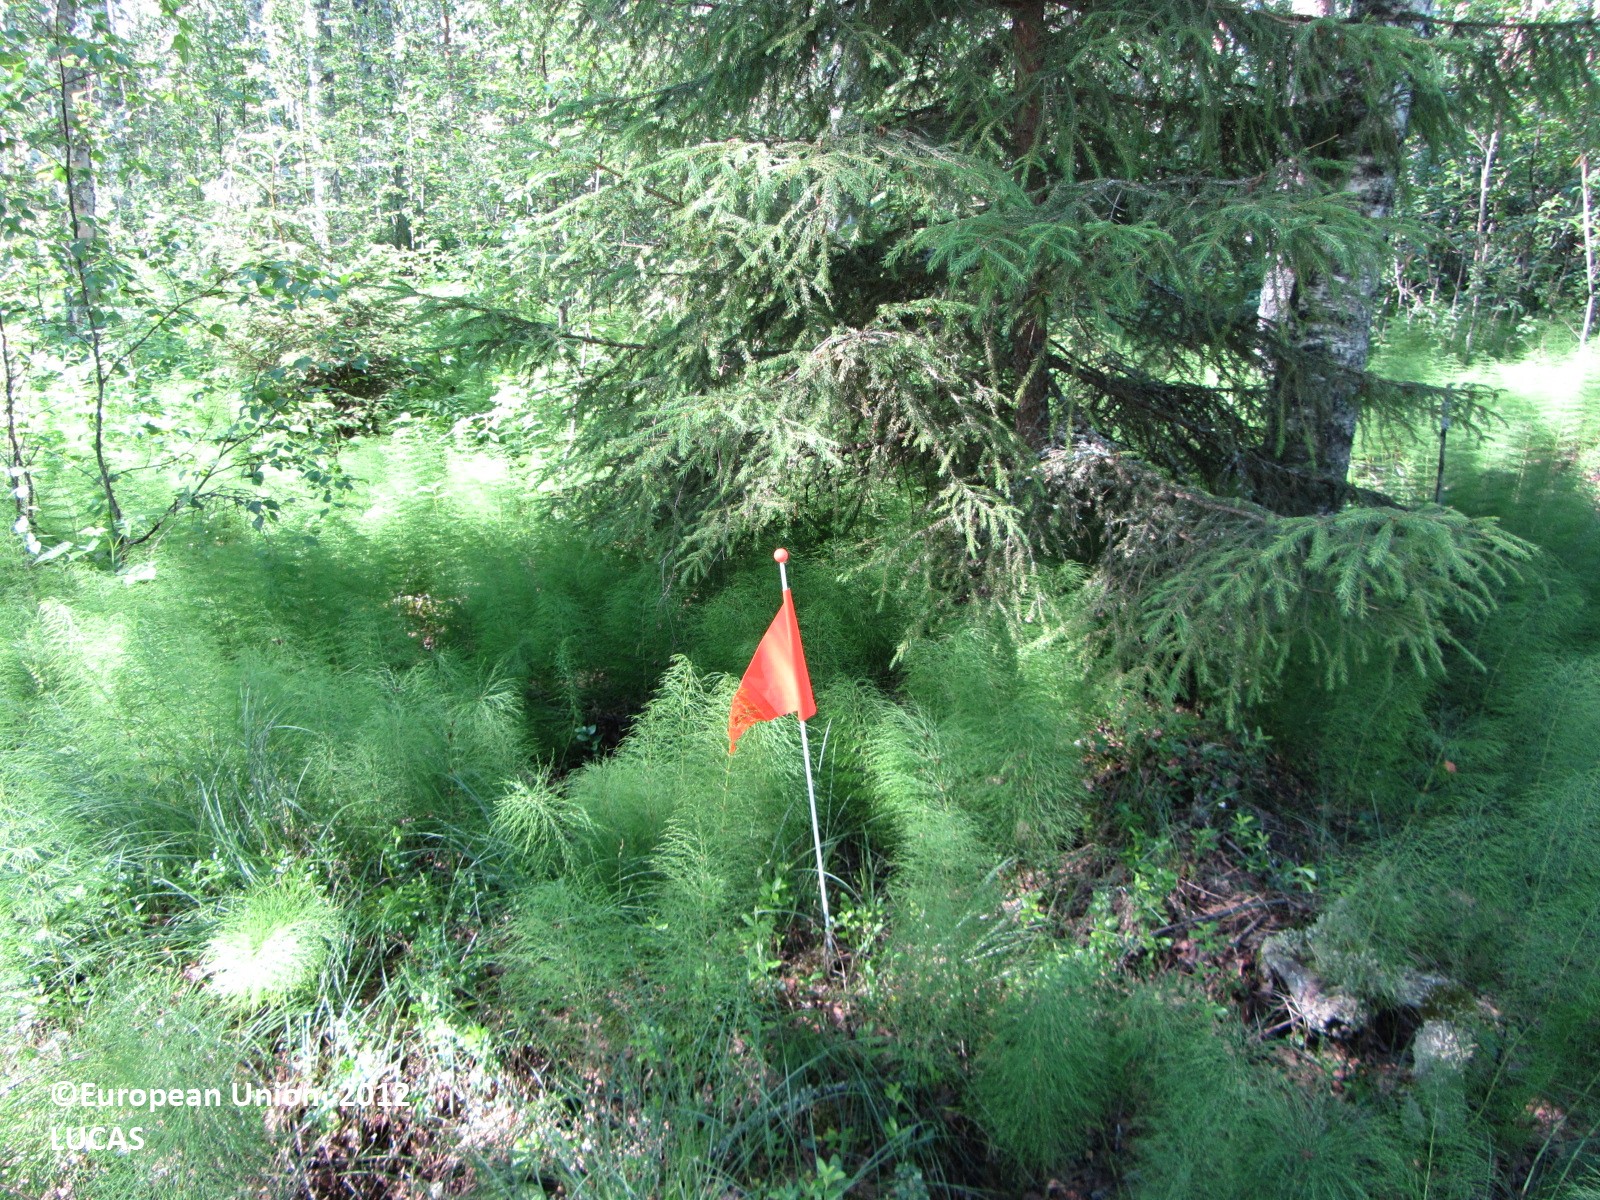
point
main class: Woodland
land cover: Other mixed woodland
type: boreal forest
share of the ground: > 75 %
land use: Forestry
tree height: > 5 m
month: July
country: FI
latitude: 63.1004
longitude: 25.2560
